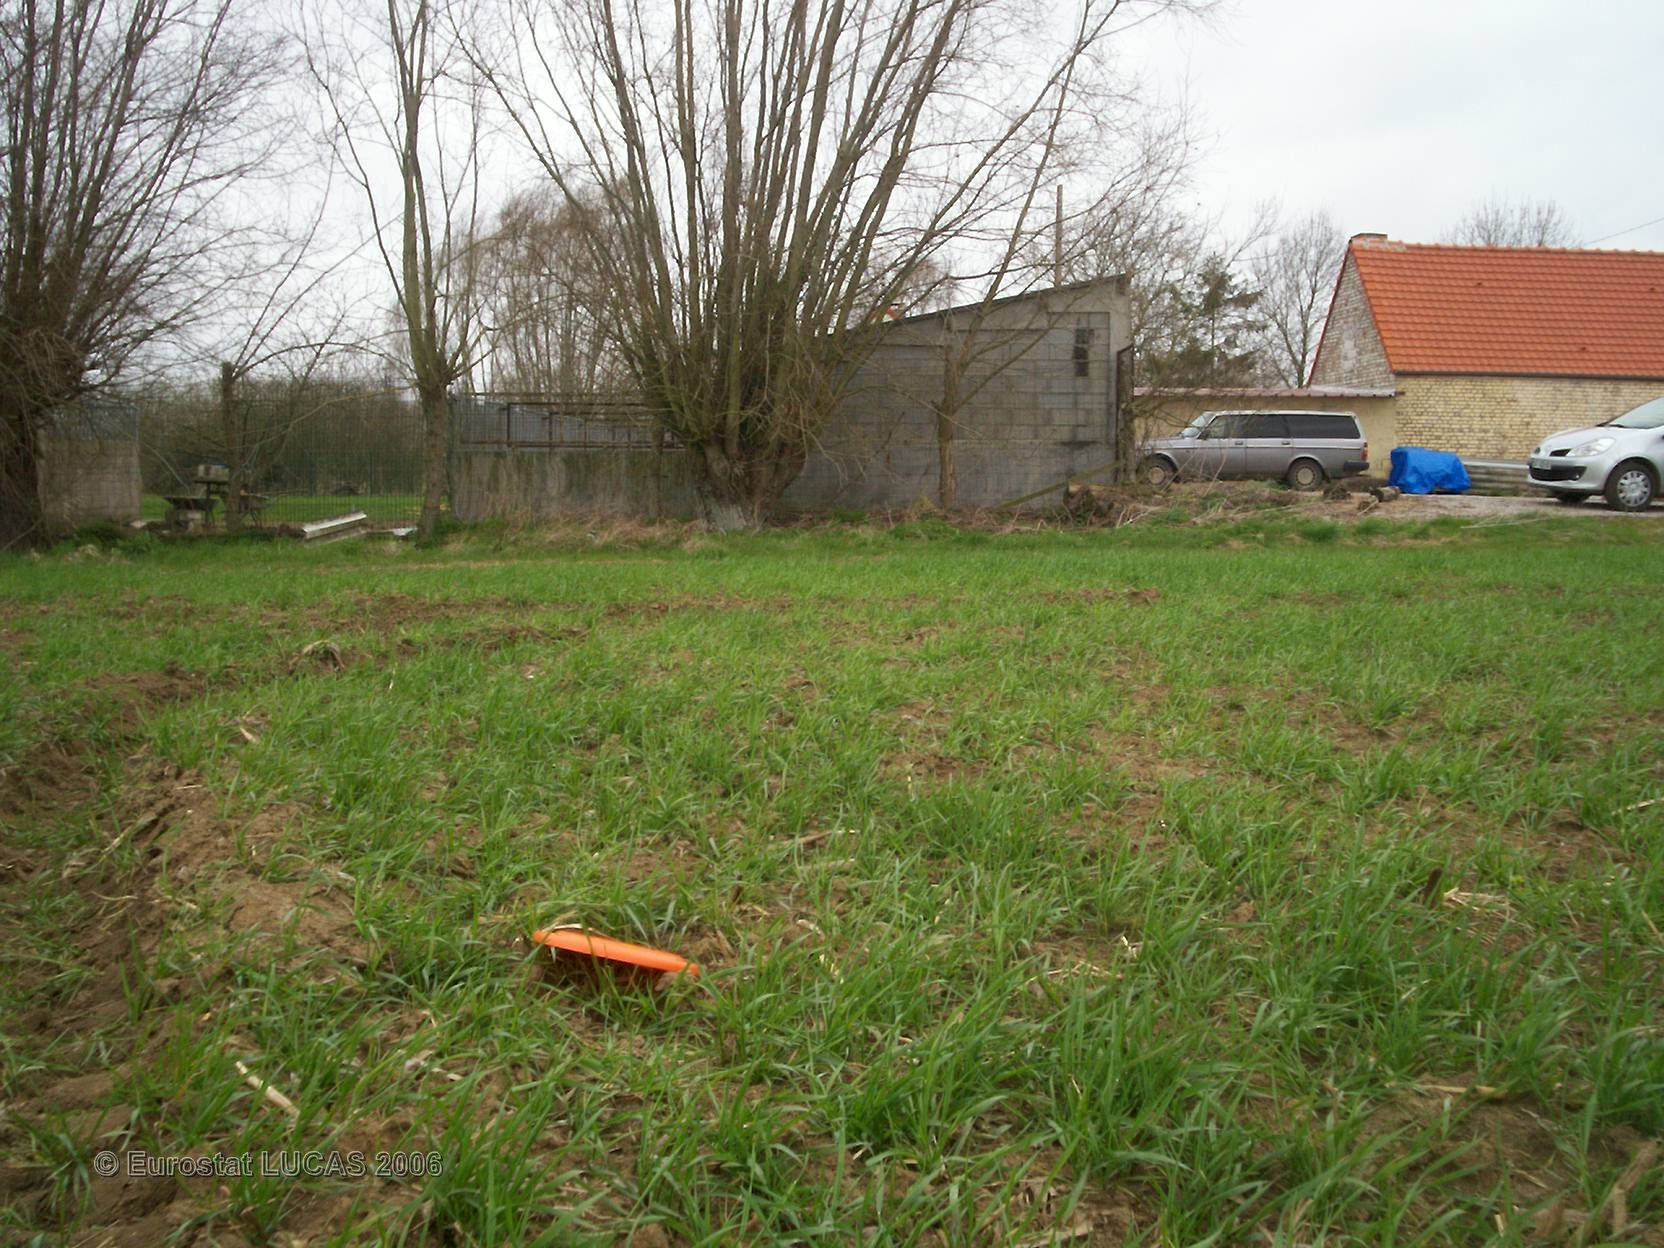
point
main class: Cropland
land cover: Common wheat
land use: Agriculture (excluding fallow land and kitchen gardens)
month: April
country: FR
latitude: 50.6061
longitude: 2.5126
